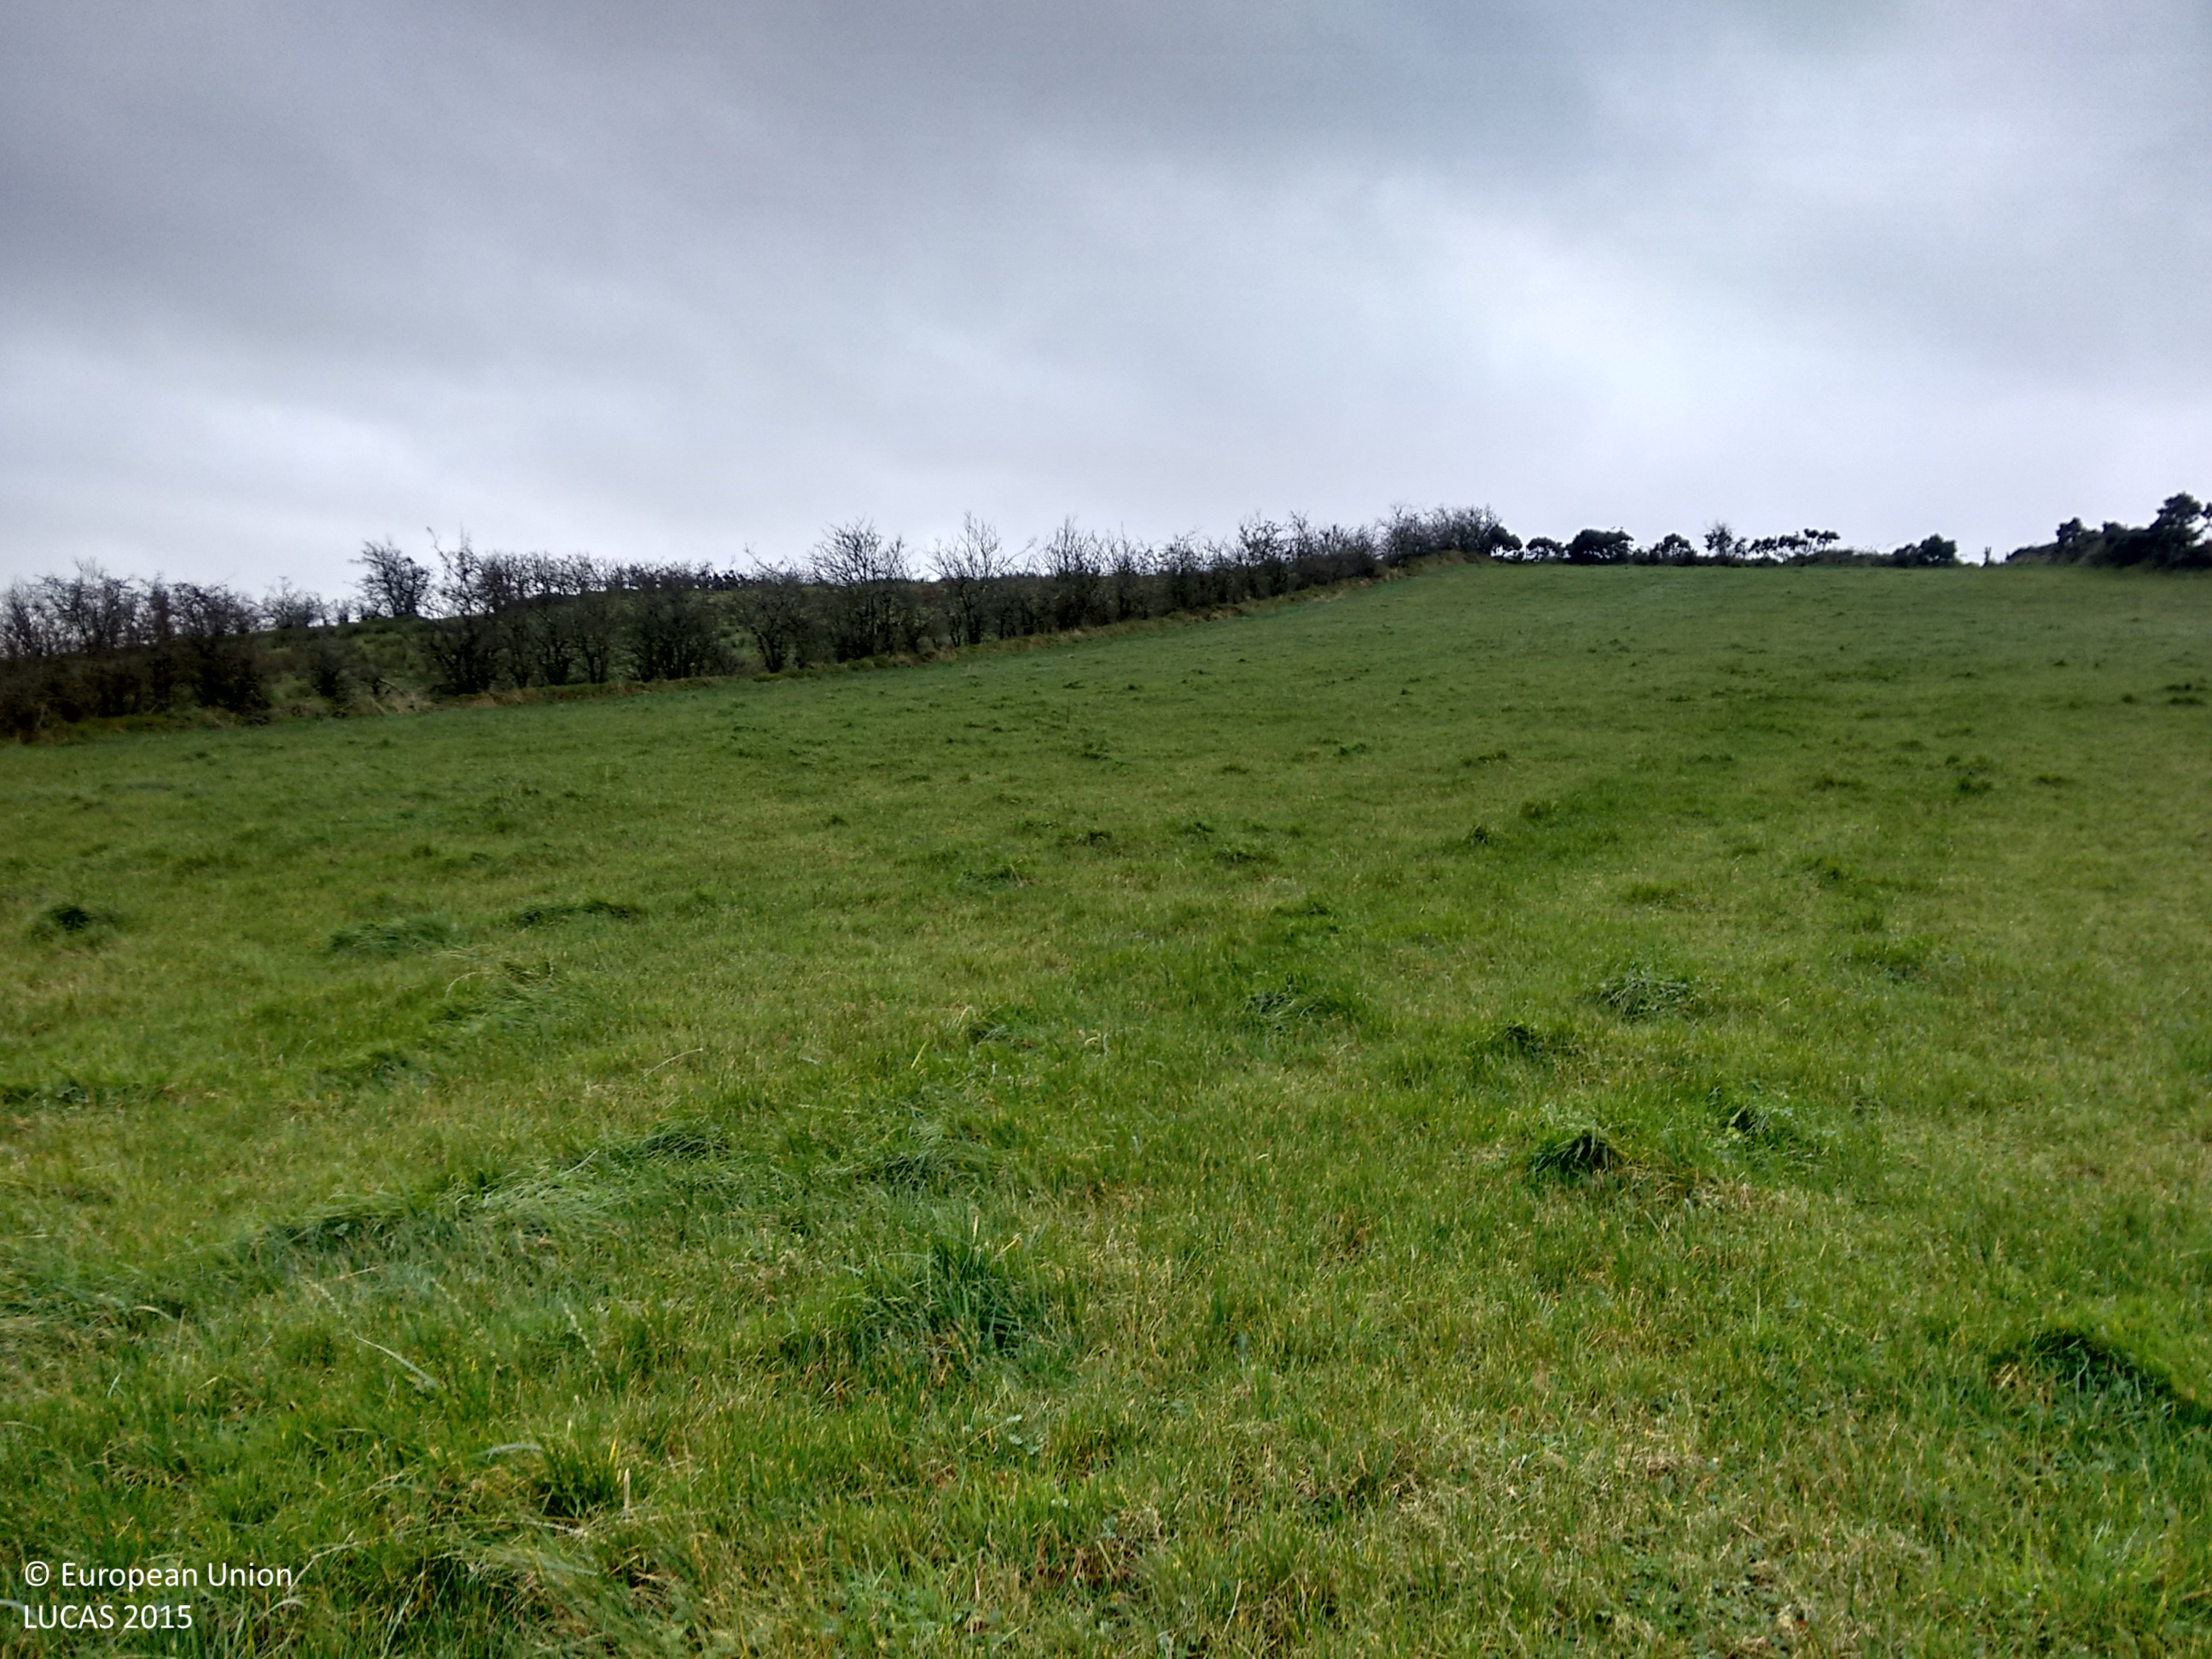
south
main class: Grassland
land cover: Grassland without tree/shrub cover
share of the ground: > 75 %
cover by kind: herbaceous plants 100 %
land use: Agriculture (excluding fallow land and kitchen gardens)
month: December
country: IE
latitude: 53.9607
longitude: -6.9505
